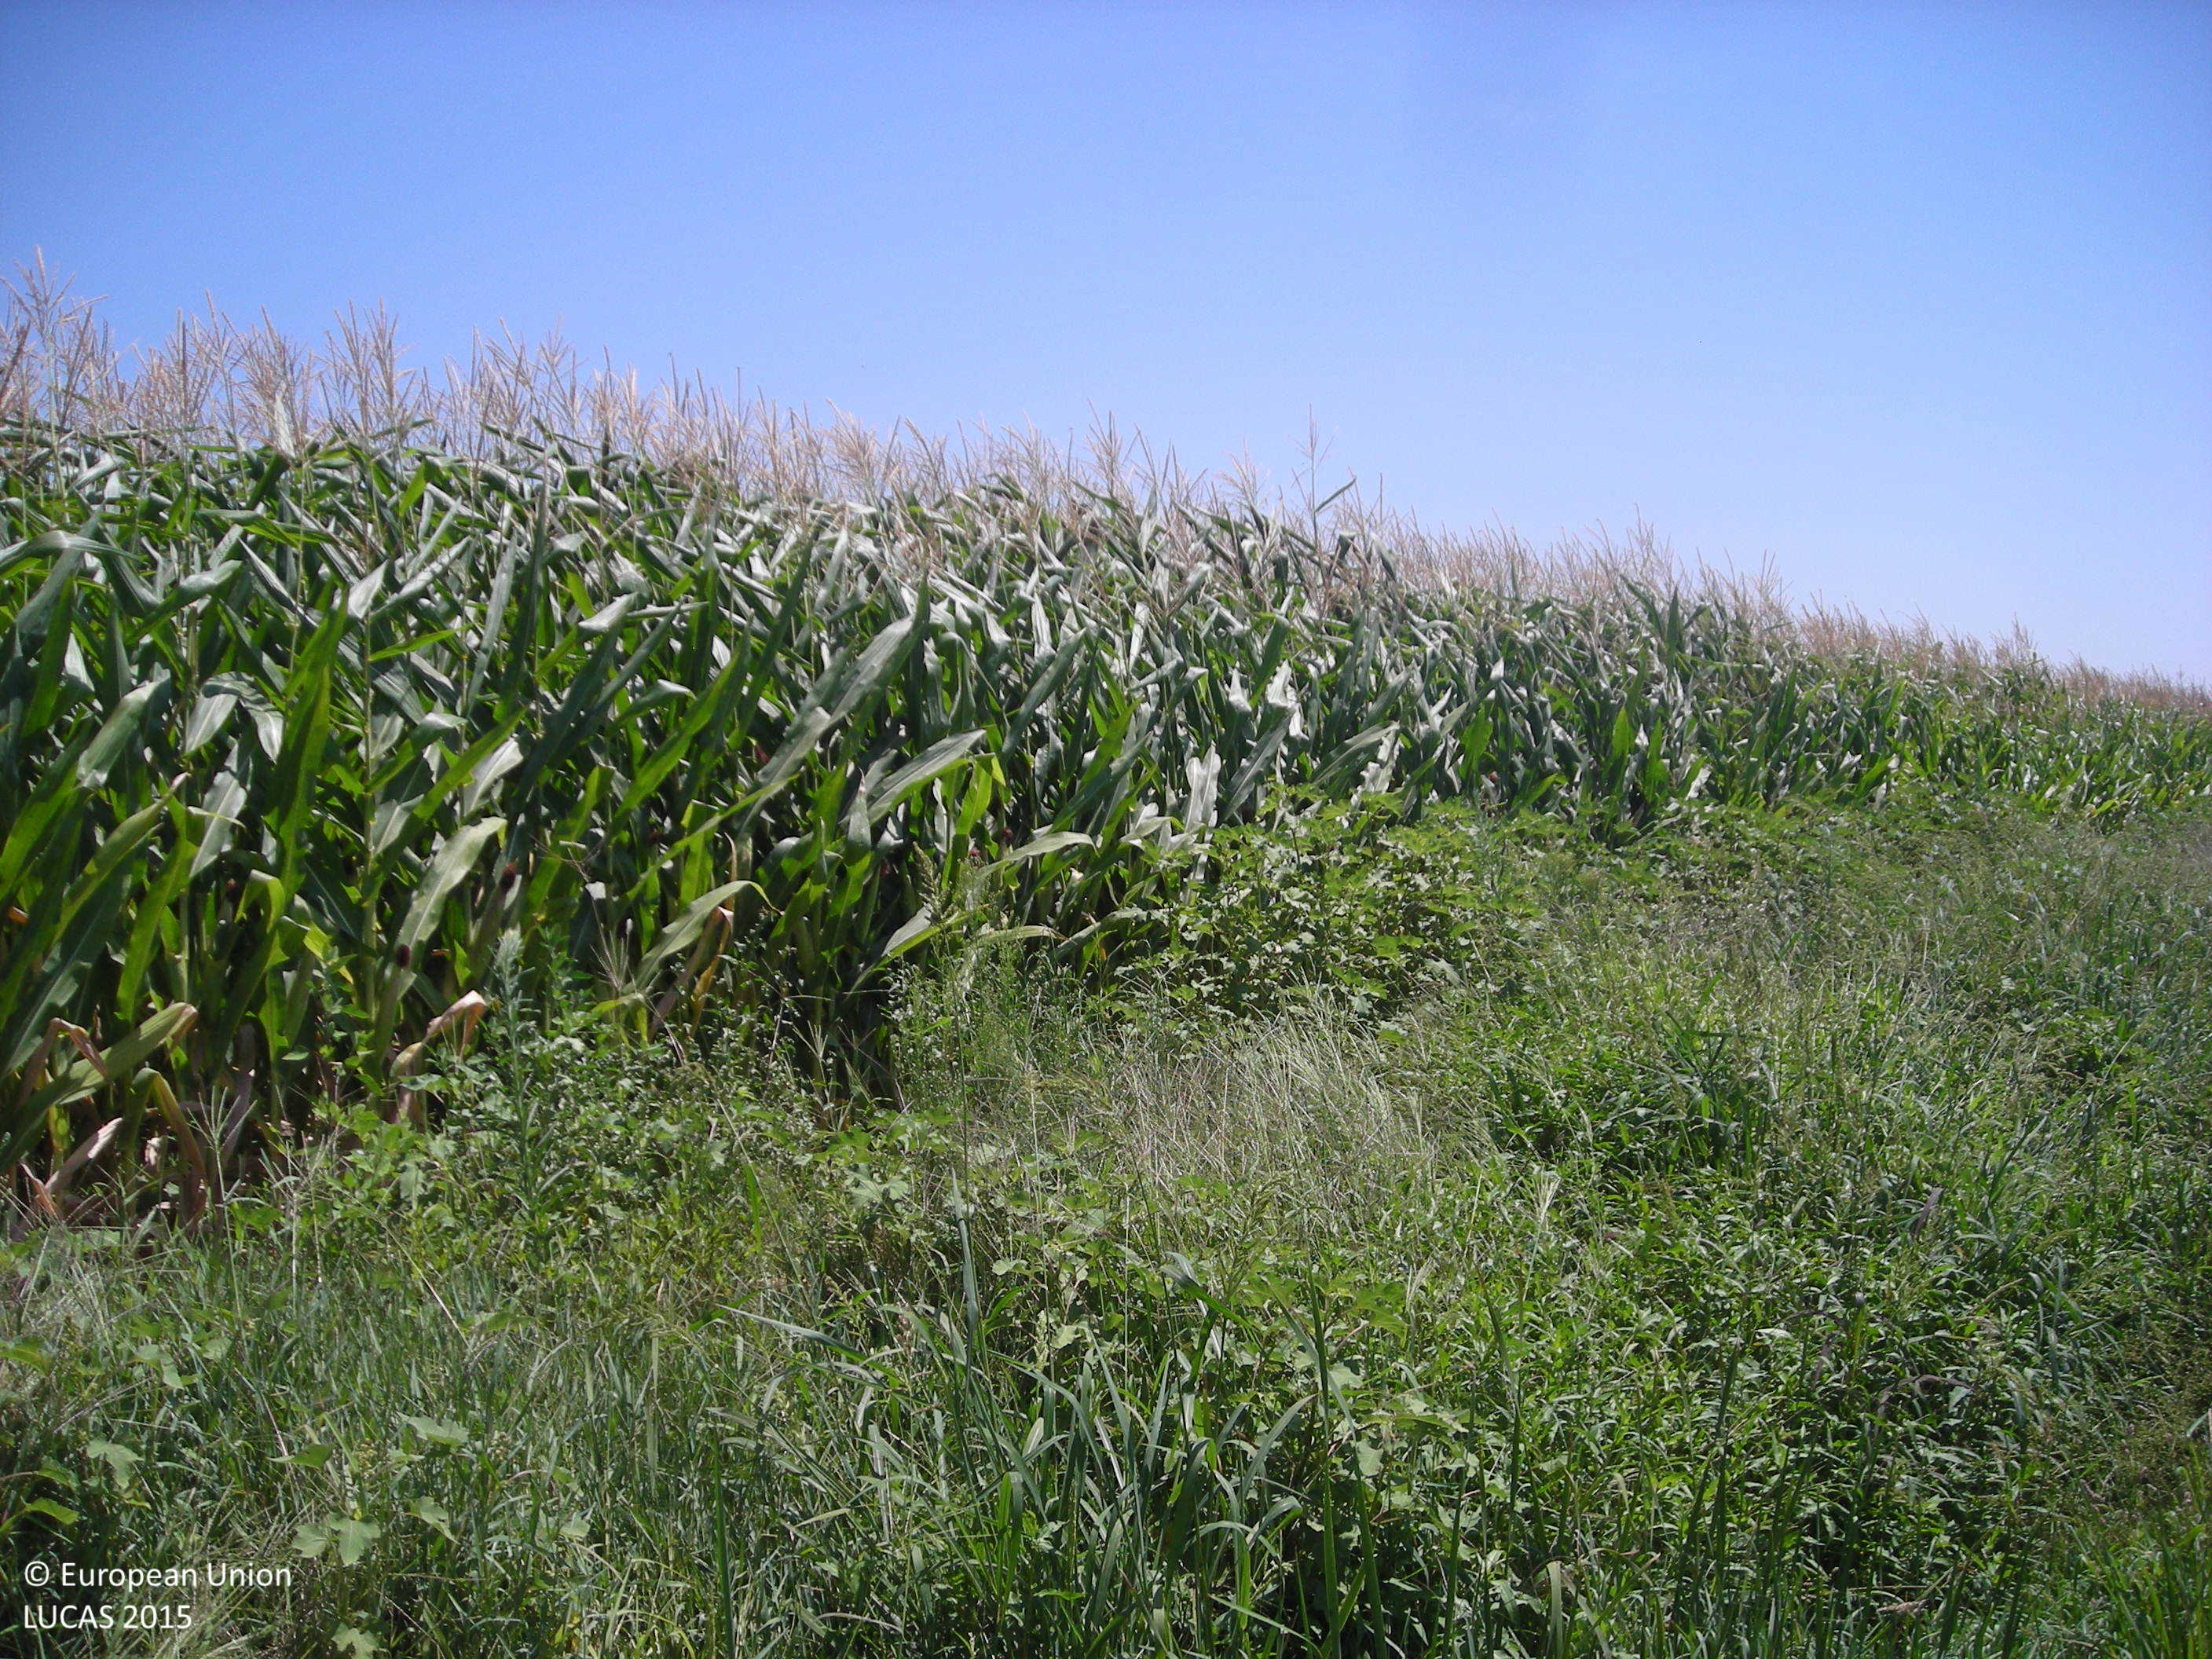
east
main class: Cropland
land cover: Maize
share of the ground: > 75 %
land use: Agriculture (excluding fallow land and kitchen gardens)
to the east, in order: Maize; Grass margins; Maize
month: July
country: ES
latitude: 39.0430
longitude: -5.9621
